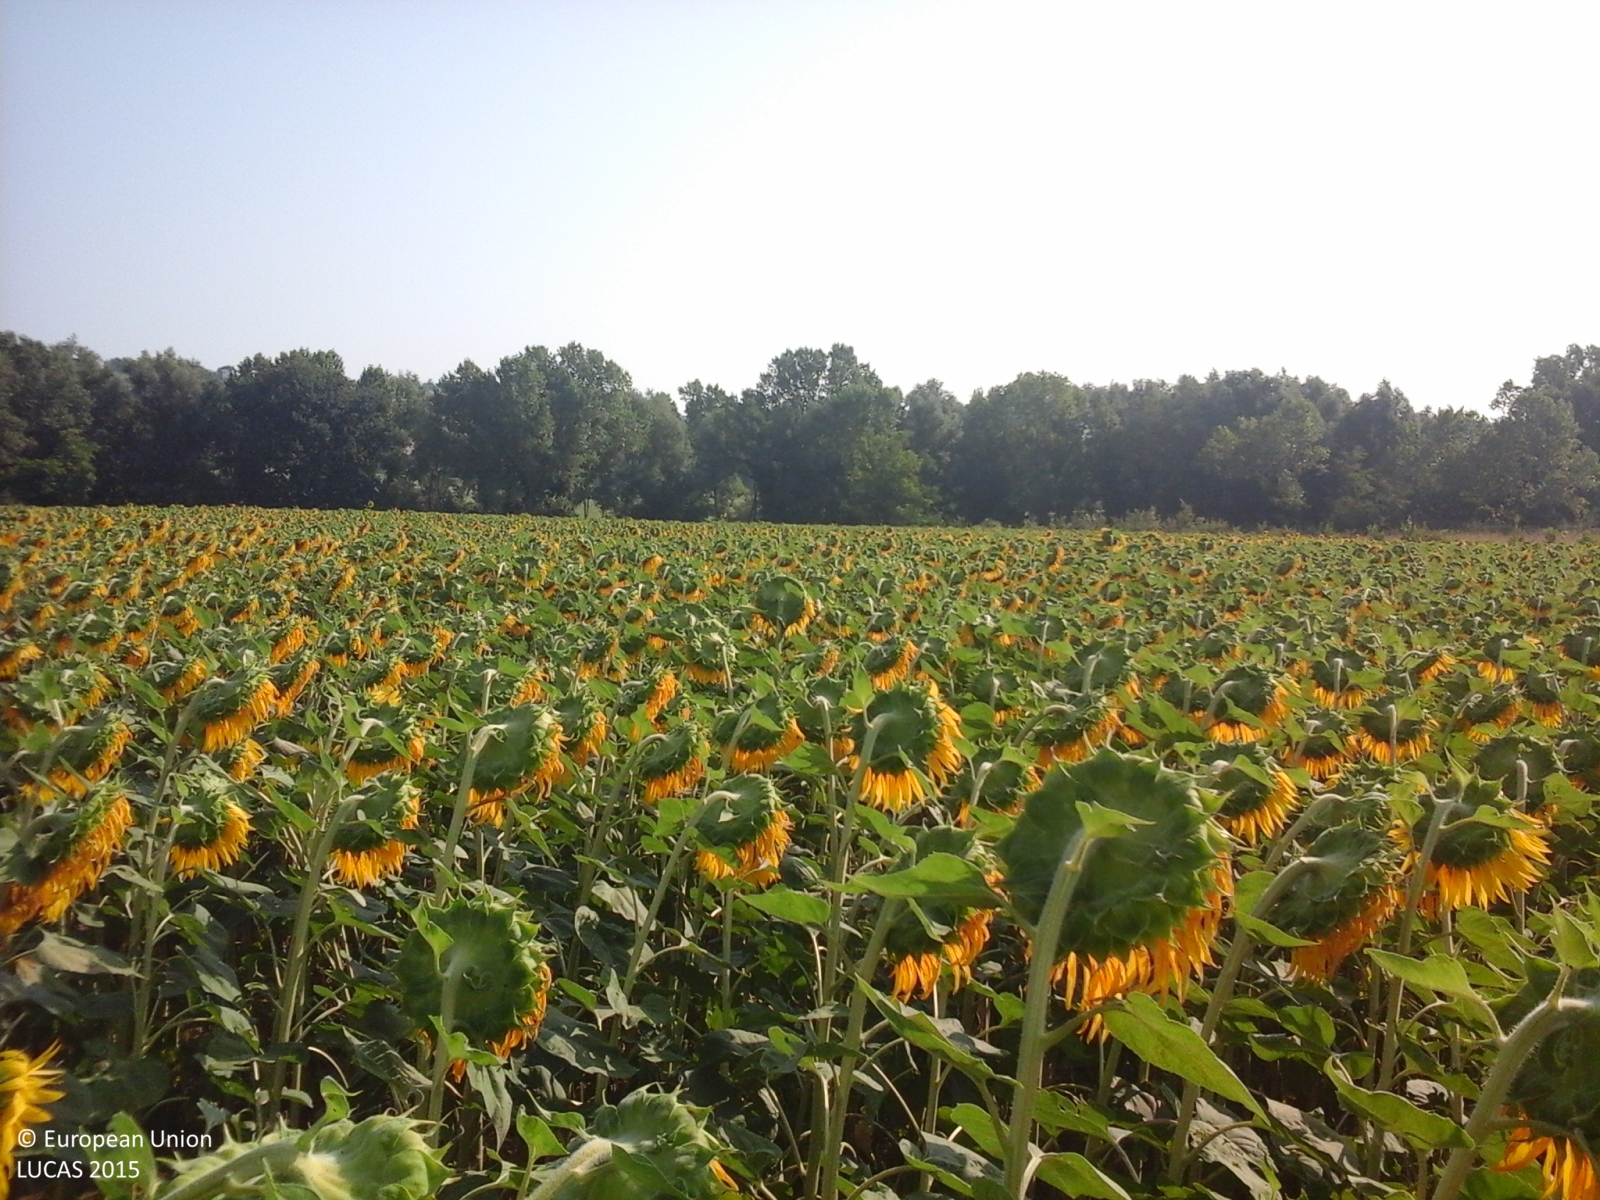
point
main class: Cropland
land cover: Sunflower
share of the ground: > 75 %
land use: Agriculture (excluding fallow land and kitchen gardens)
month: July
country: IT
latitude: 43.3471
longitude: 13.6548
